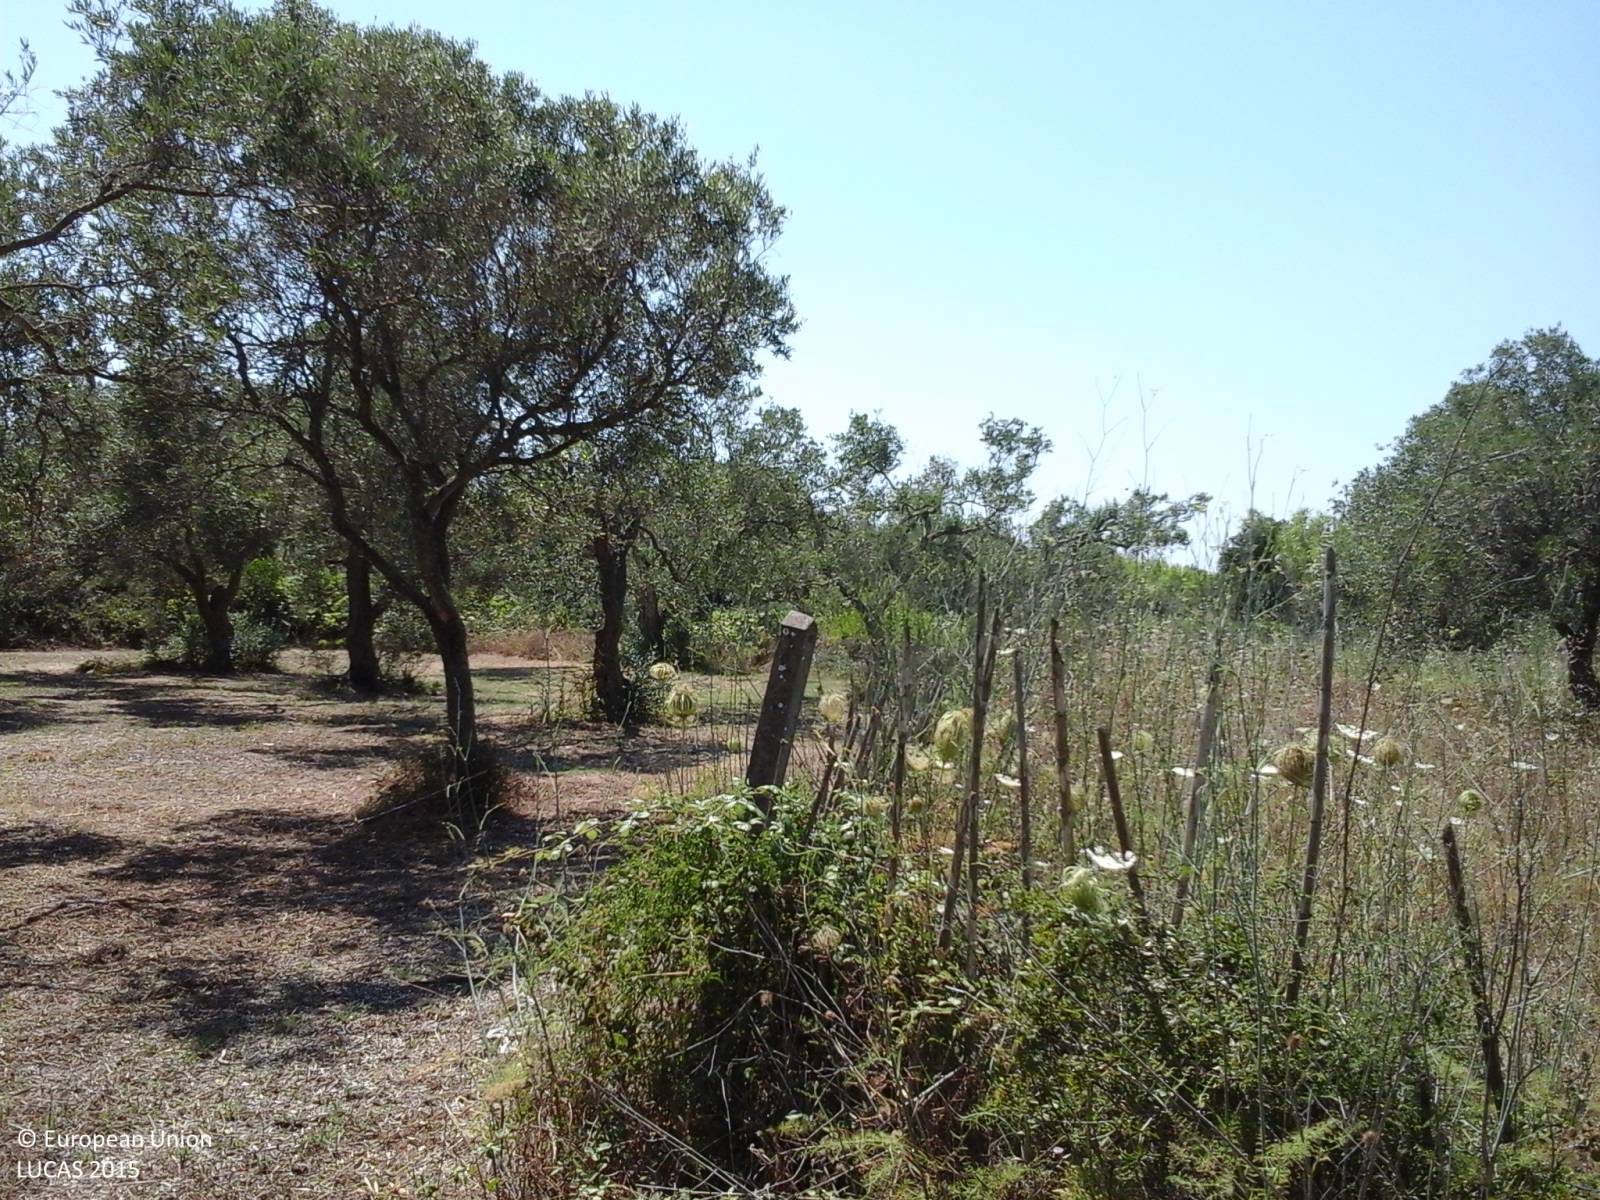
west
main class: Cropland
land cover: Olive groves
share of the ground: > 75 %
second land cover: Grassland without tree/shrub cover
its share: > 75 %
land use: Agriculture (excluding fallow land and kitchen gardens)
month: July
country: IT
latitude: 39.9665
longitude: 8.5212
